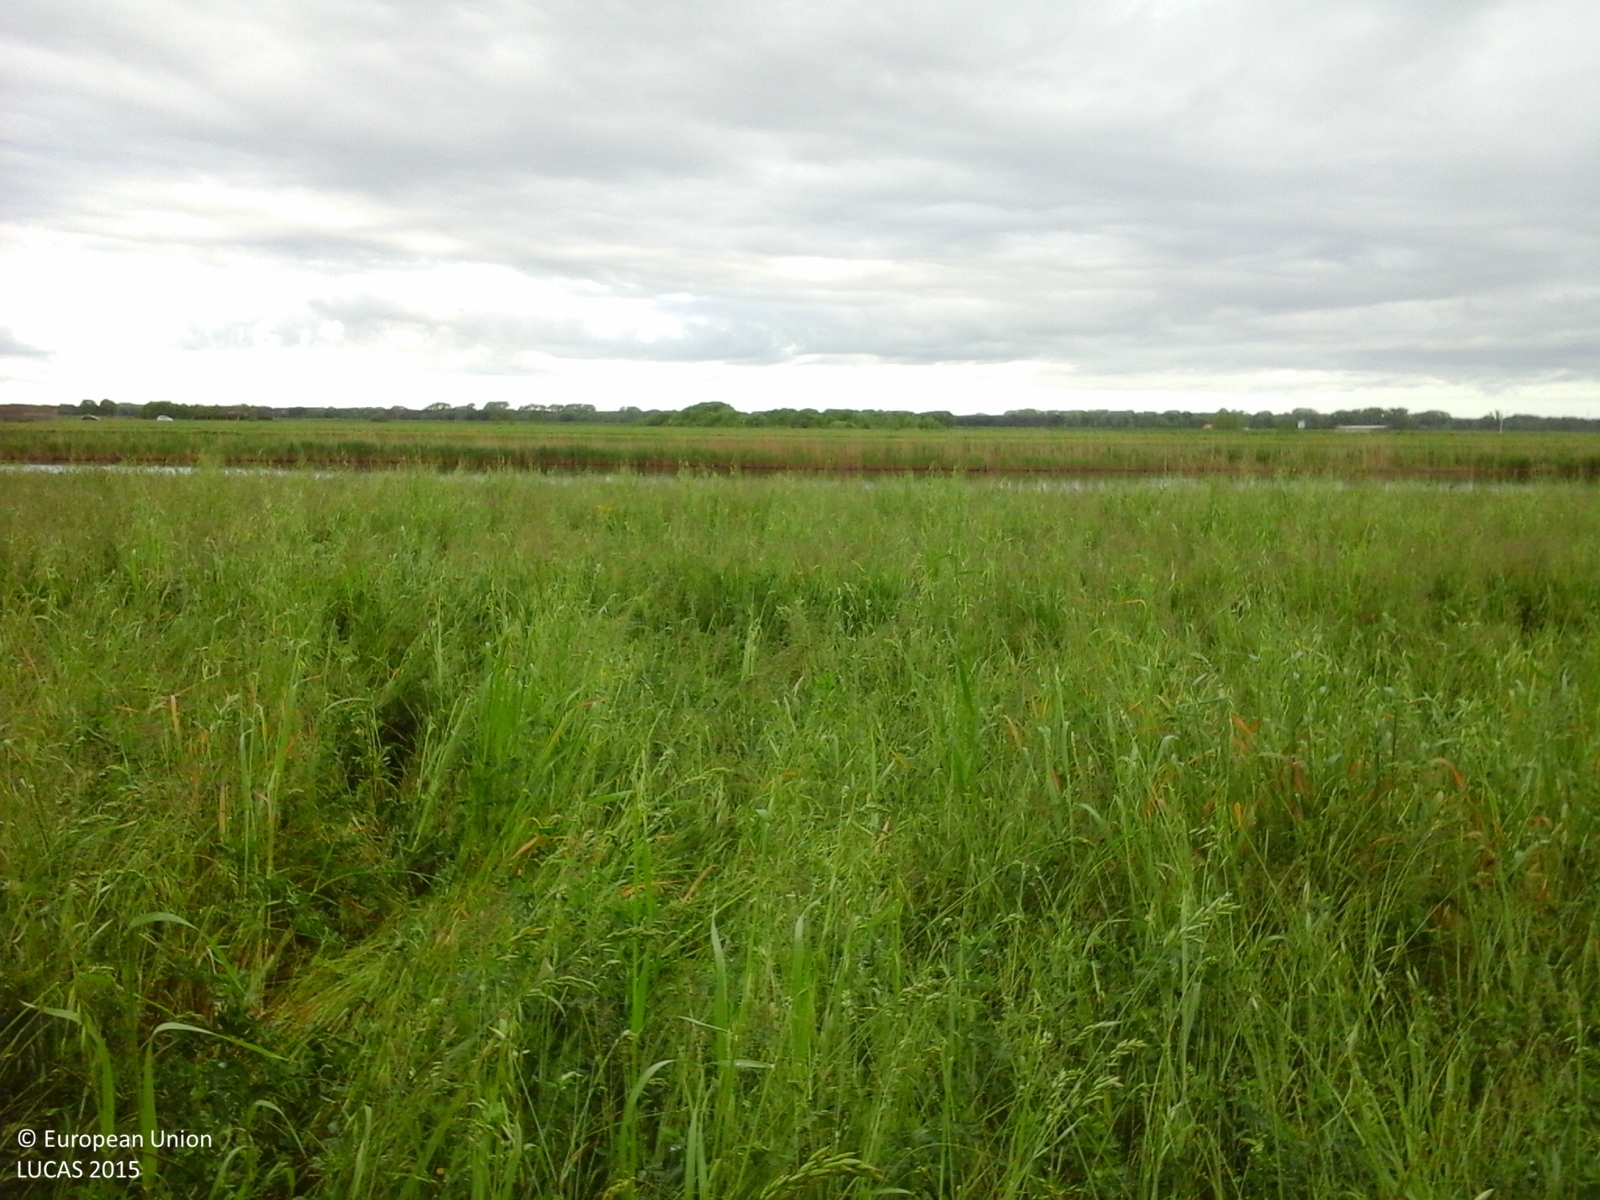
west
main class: Cropland
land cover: Lucerne
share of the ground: > 75 %
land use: Agriculture (excluding fallow land and kitchen gardens)
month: April
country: IT
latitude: 44.8666
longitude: 12.2866
